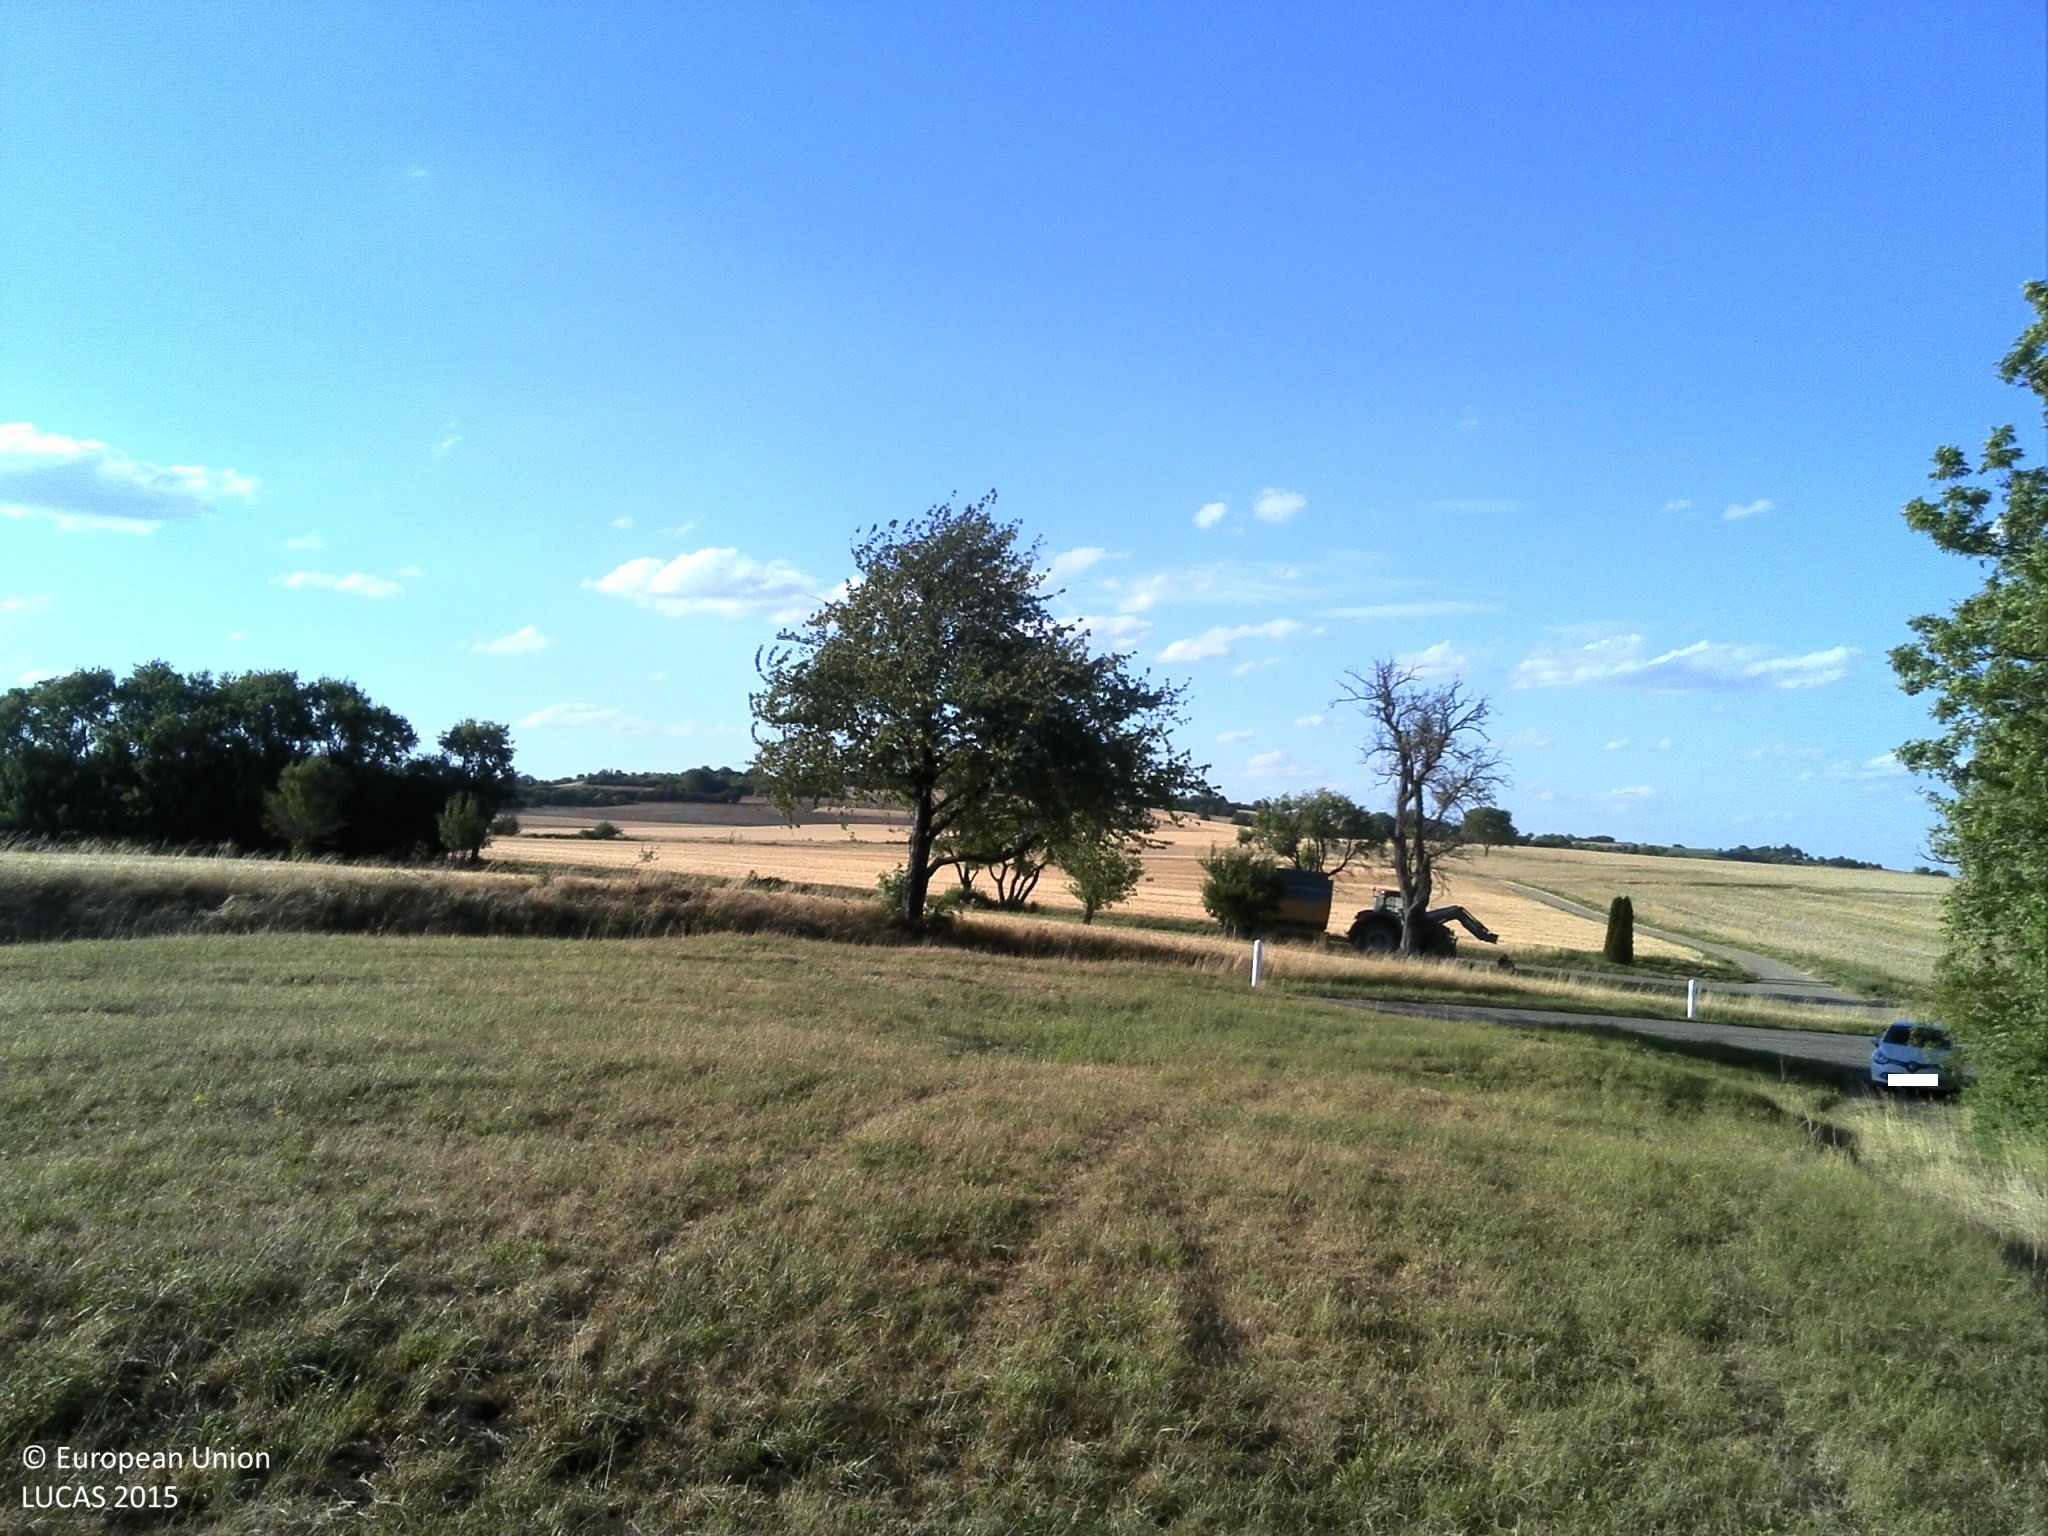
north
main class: Grassland
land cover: Grassland without tree/shrub cover
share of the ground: > 75 %
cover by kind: herbaceous plants 100 %
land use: Agriculture (excluding fallow land and kitchen gardens)
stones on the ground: < 10 %
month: July
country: FR
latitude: 49.1086
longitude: 7.3018
